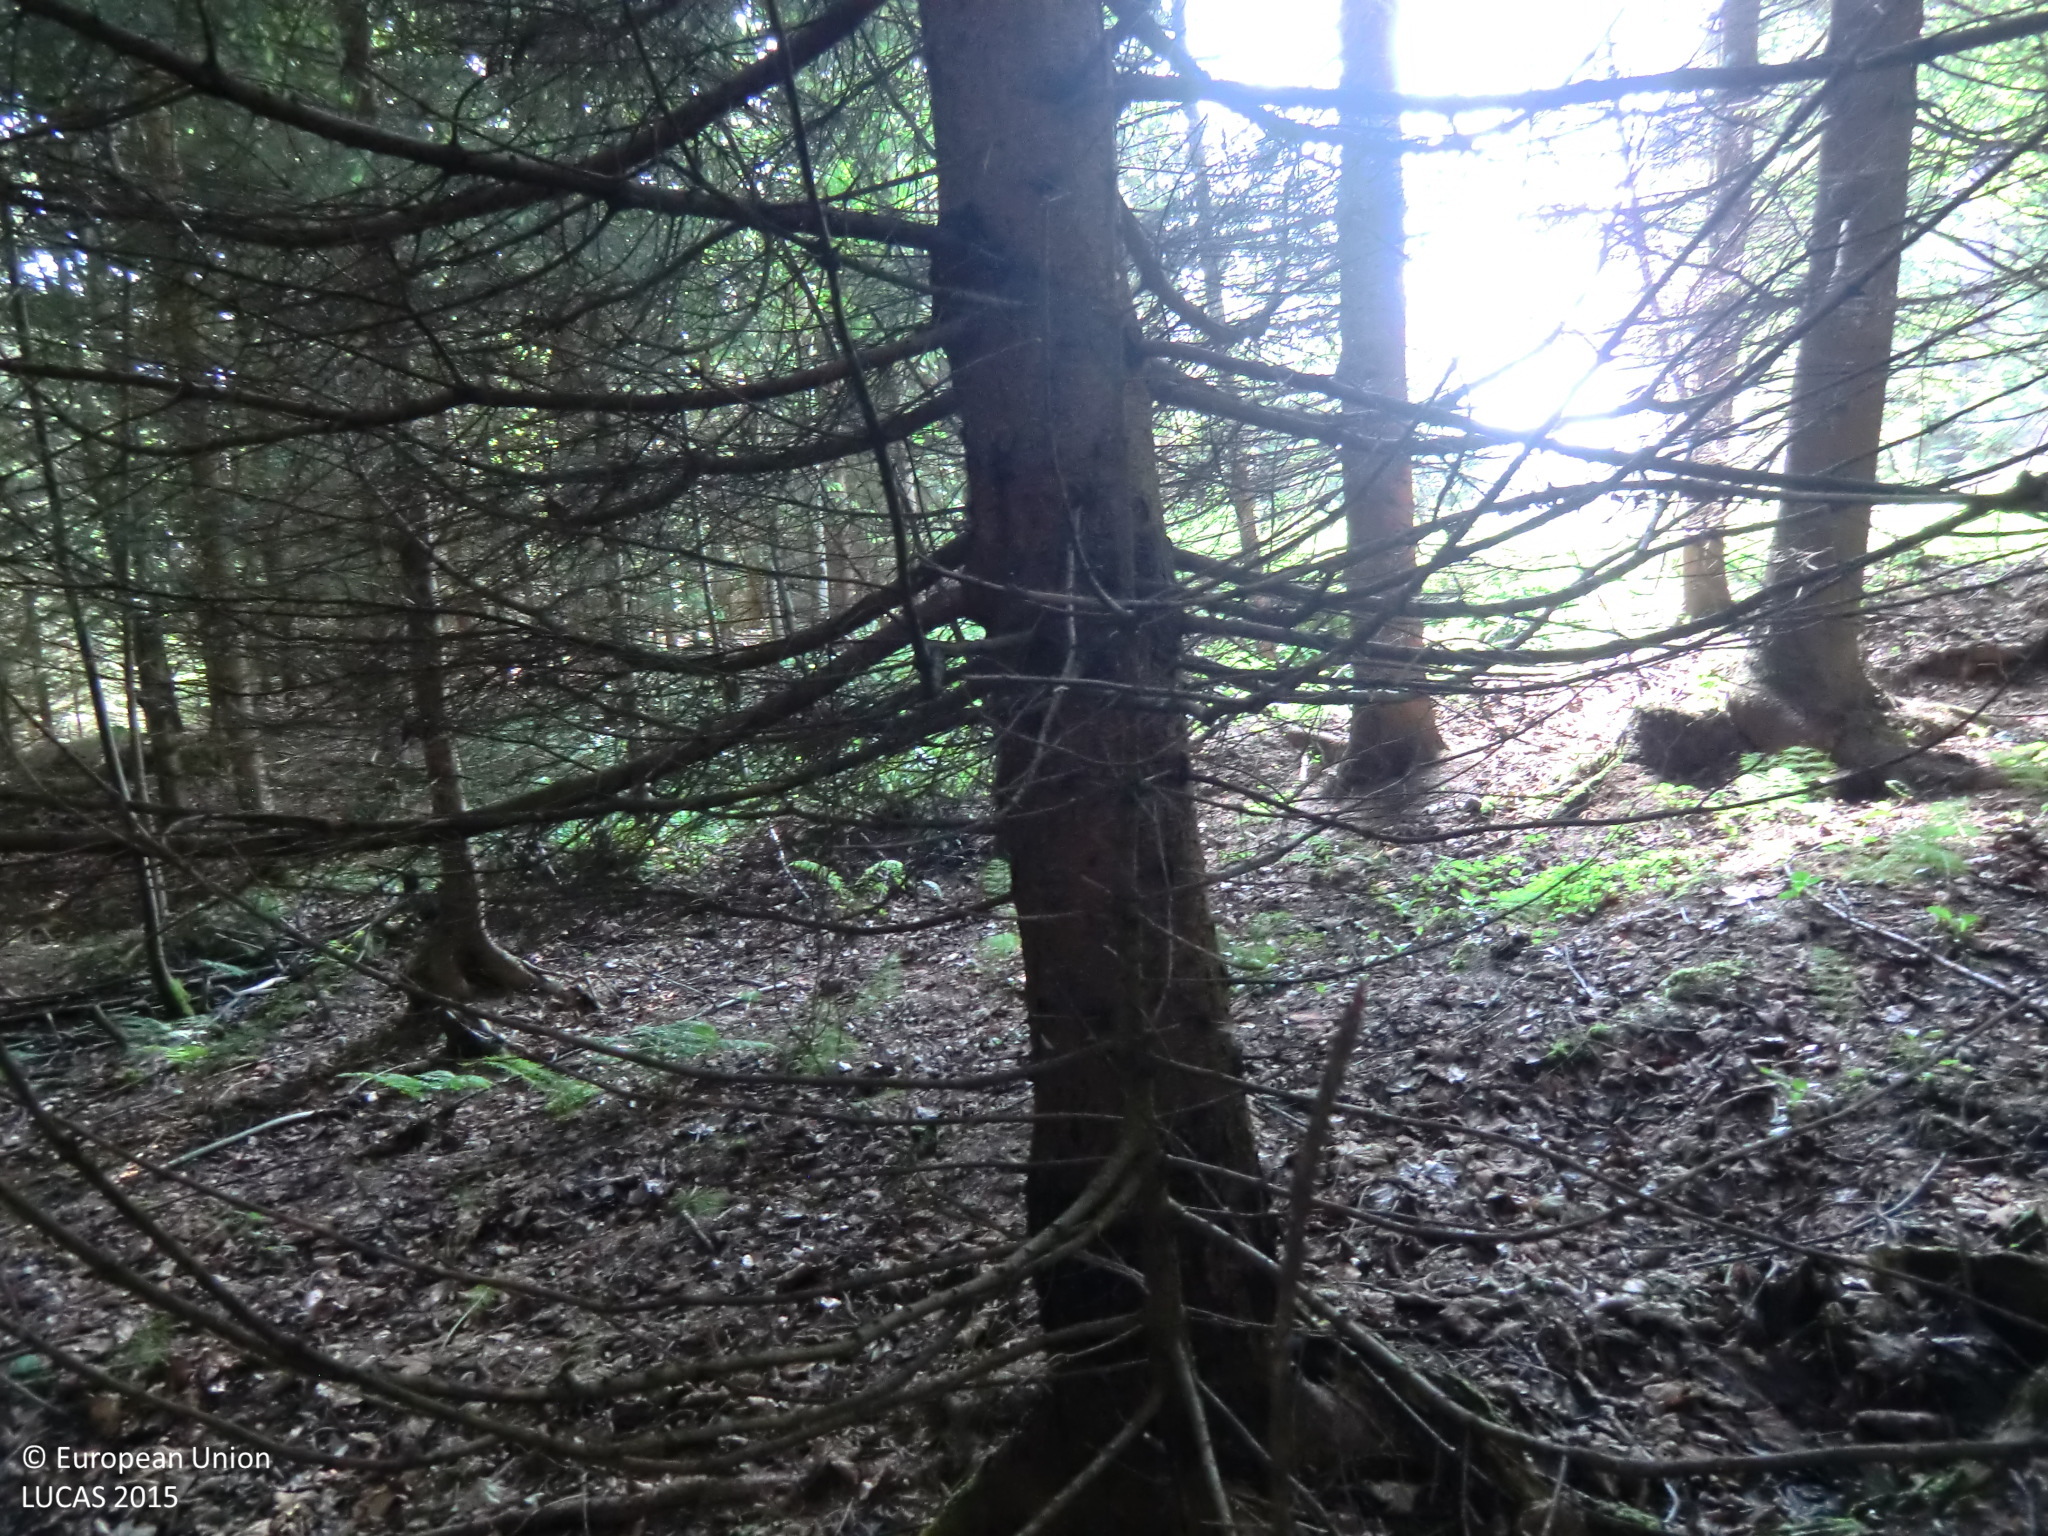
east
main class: Woodland
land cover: Spruce dominated coniferous woodland
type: hemiboreal forest and nemoral coniferous forest and mixed broadleaved-coniferous forest
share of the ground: > 75 %
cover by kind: coniferous forest trees 90 %, broadleaved forest trees 10 %
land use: Forestry
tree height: > 5 m
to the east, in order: Spruce dominated coniferous woodland; Rivers and streams; Spruce dominated coniferous woodland; Spruce dominated mixed woodland; Tracks; Spruce dominated coniferous woodland; Spruce dominated mixed woodland; Spruce dominated coniferous woodland; Spruce dominated mixed woodland; Rivers and streams; Spruce dominated coniferous woodland
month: June
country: AT
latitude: 48.4770
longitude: 14.8577
